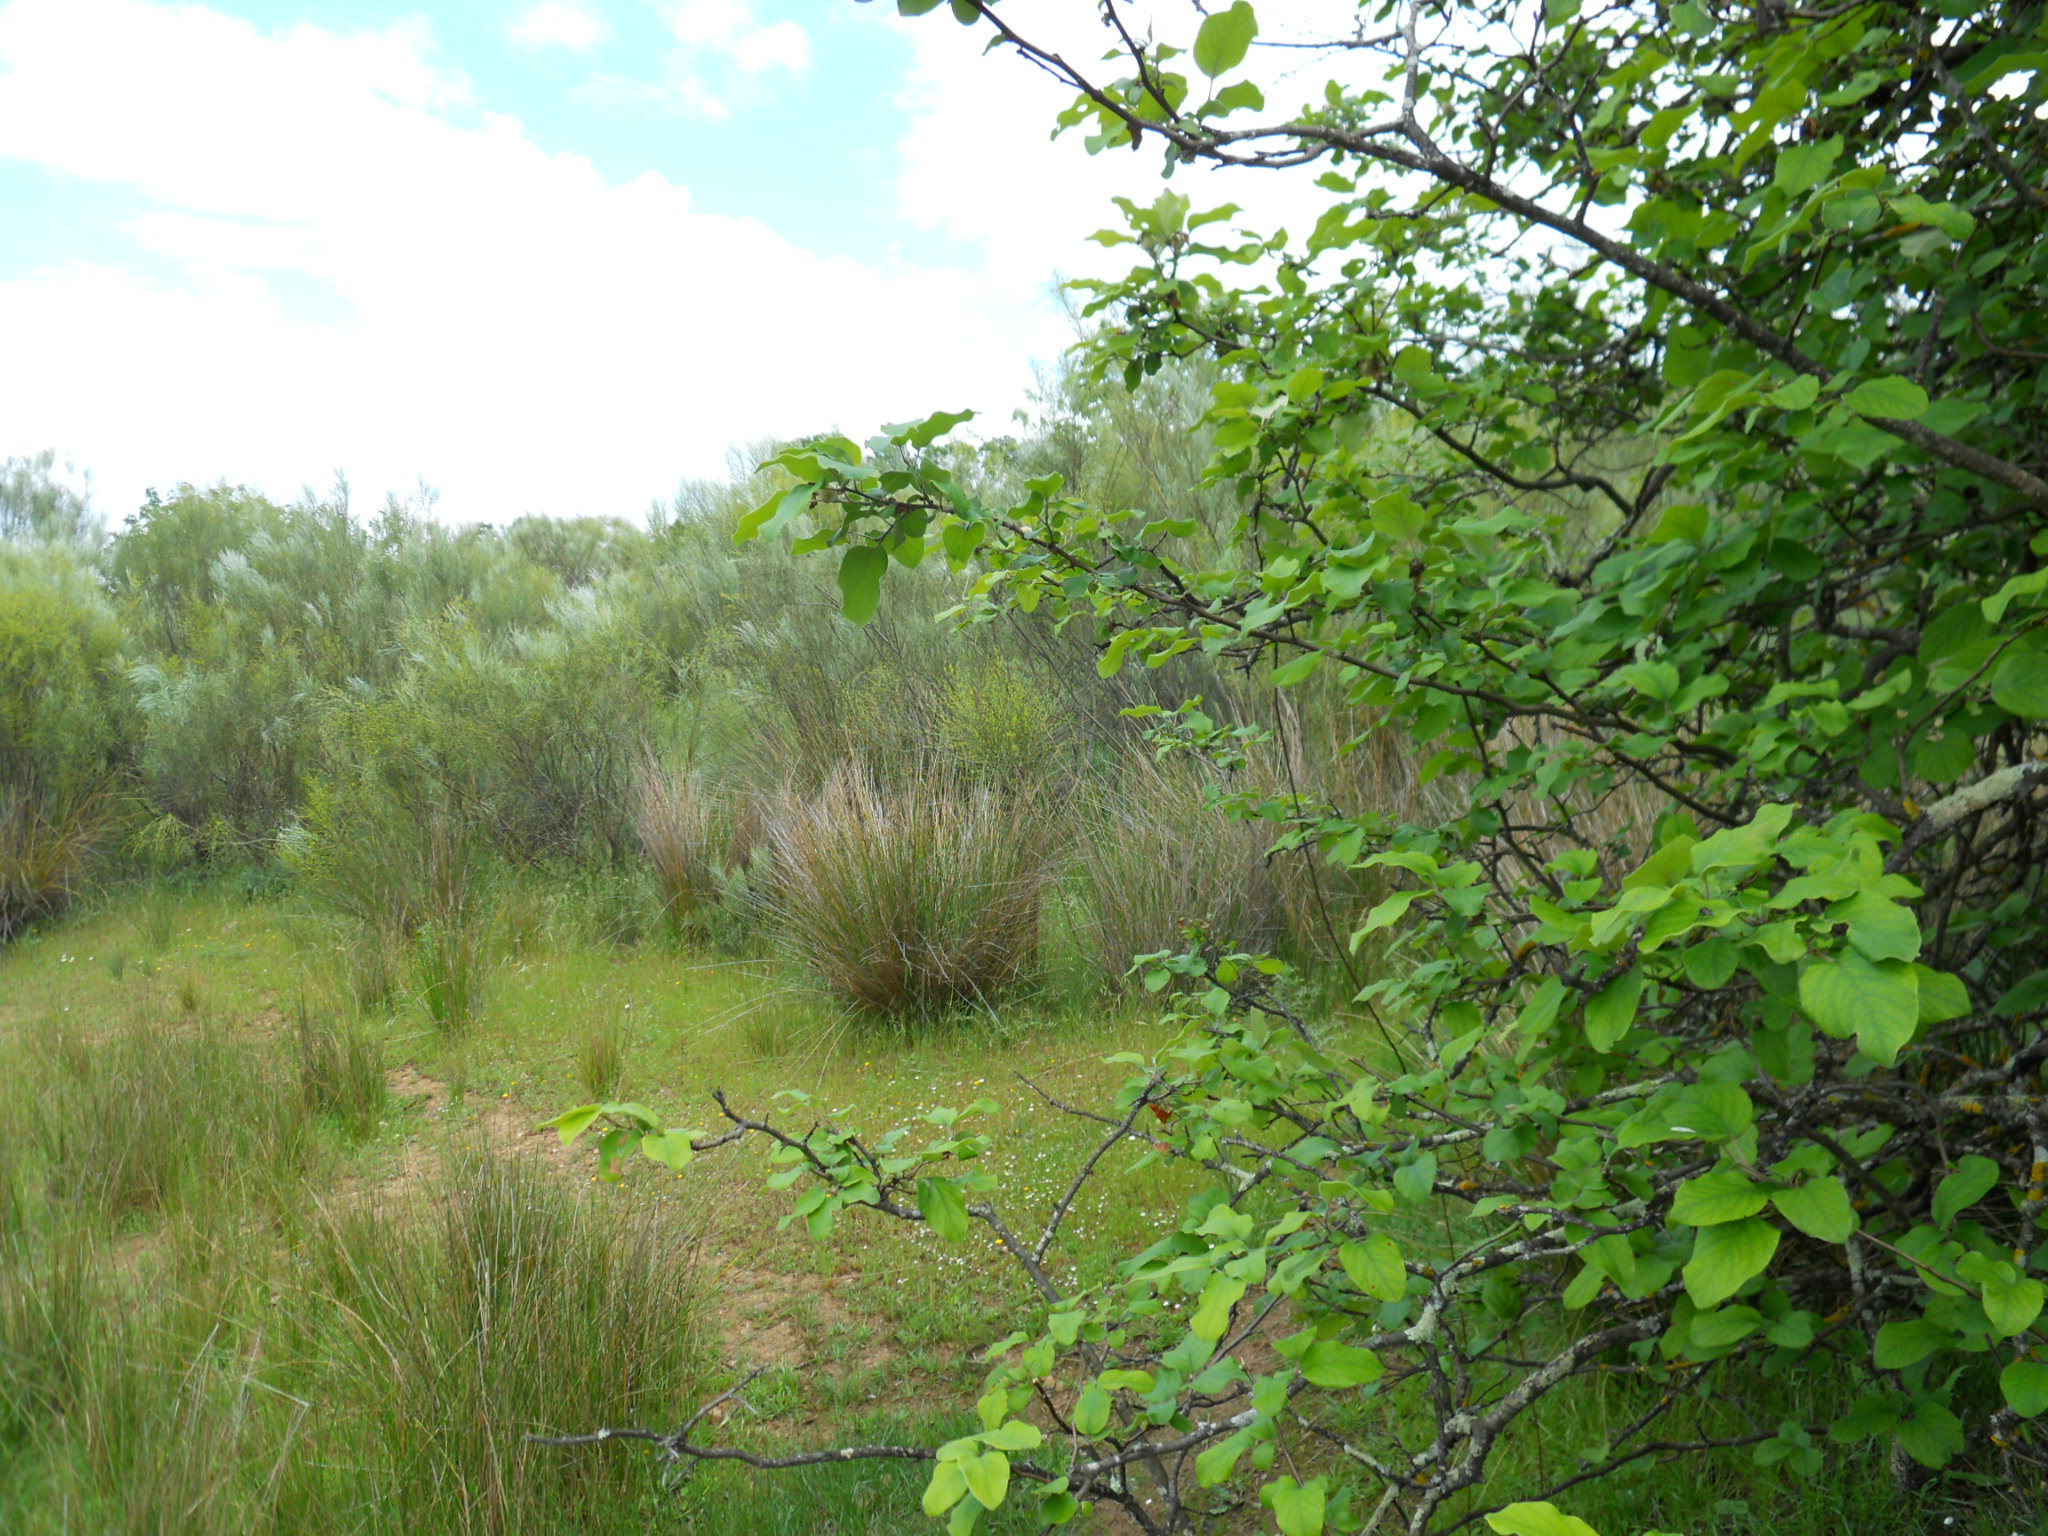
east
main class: Shrubland
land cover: Shrubland with sparse tree cover
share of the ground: > 75 %
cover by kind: shrubs 80 %, herbaceous plants 15 %, broadleaved forest trees 5 %
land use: Agriculture (excluding fallow land and kitchen gardens)
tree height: > 5 m
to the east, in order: Shrubland with sparse tree cover; Electric lines; Shrubland with sparse tree cover; Broadleaved woodland; Fences; Grass margins; Paved roads, cycling and walking lanes; Grass margins; Fences; Broadleaved woodland; Shrubland with sparse tree cover; Abandoned hedges; Shrubland with sparse tree cover
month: May
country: ES
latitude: 39.1616
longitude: -6.9835
